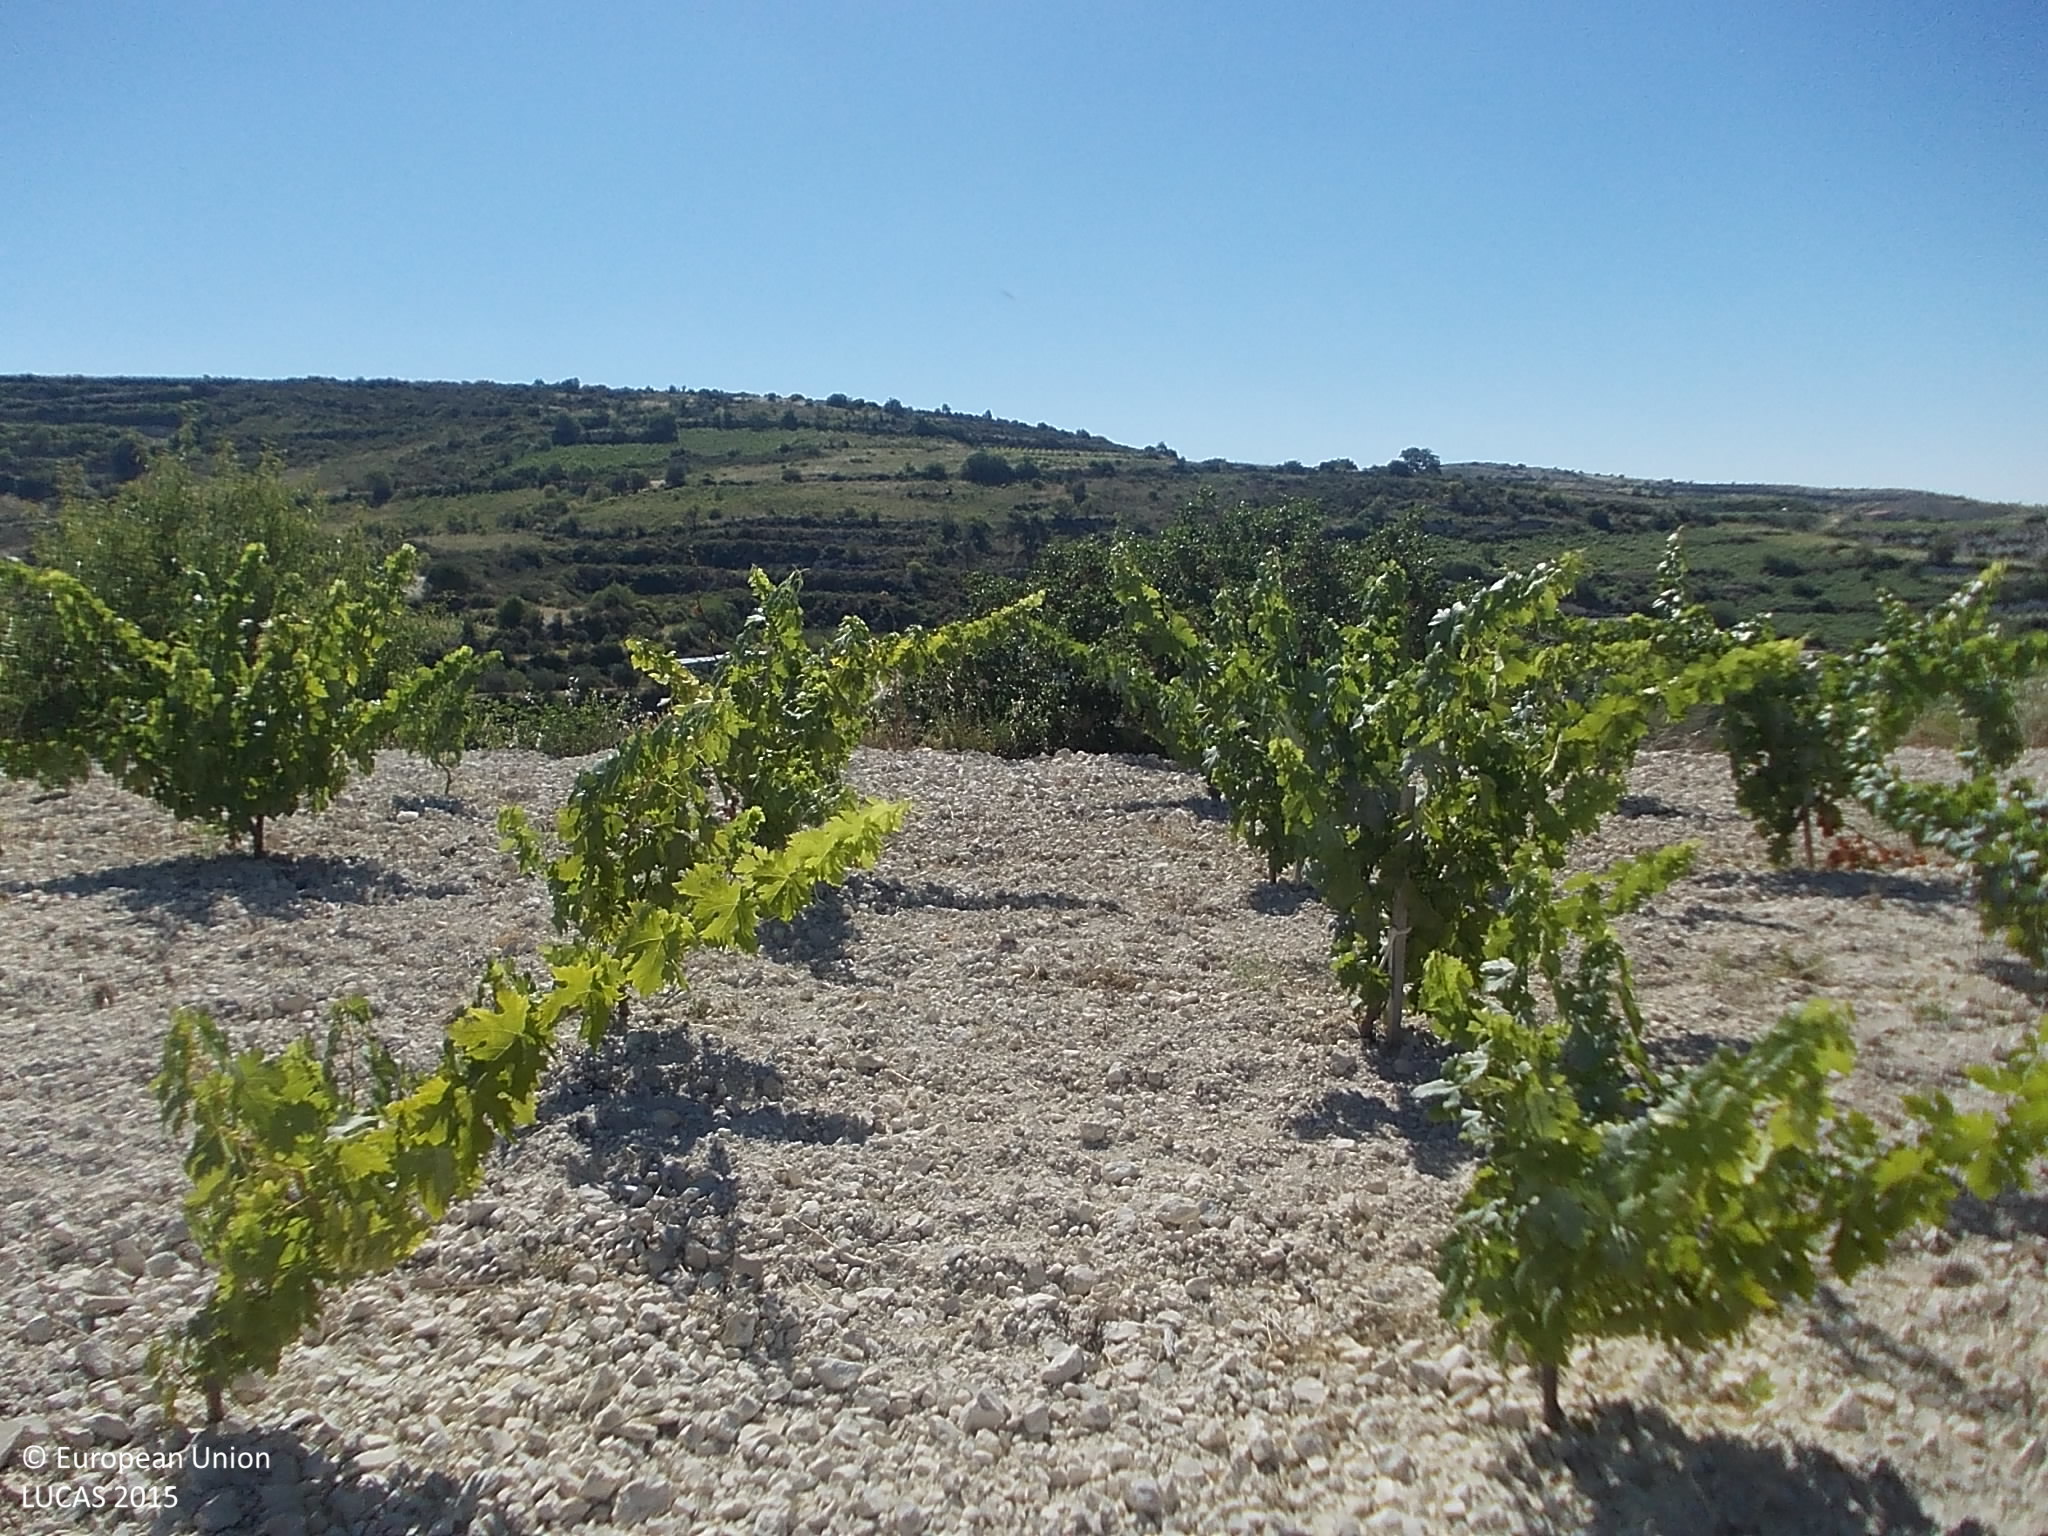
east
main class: Cropland
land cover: Vineyards
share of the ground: 10 - 25 %
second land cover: Rocks and stones
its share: > 75 %
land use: Agriculture (excluding fallow land and kitchen gardens)
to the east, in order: Abandoned hedges; Vineyards; Shrubland without tree cover; Tracks; Shrubland without tree cover; Vineyards; Dry stone walls; Shrubland without tree cover; Vineyards; Shrubland without tree cover; Nuts trees; Shrubland without tree cover; Tracks; Shrubland without tree cover; Tracks; Shrubland without tree cover; Olive groves; Vineyards
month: July
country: CY
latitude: 34.8531
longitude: 32.7673
